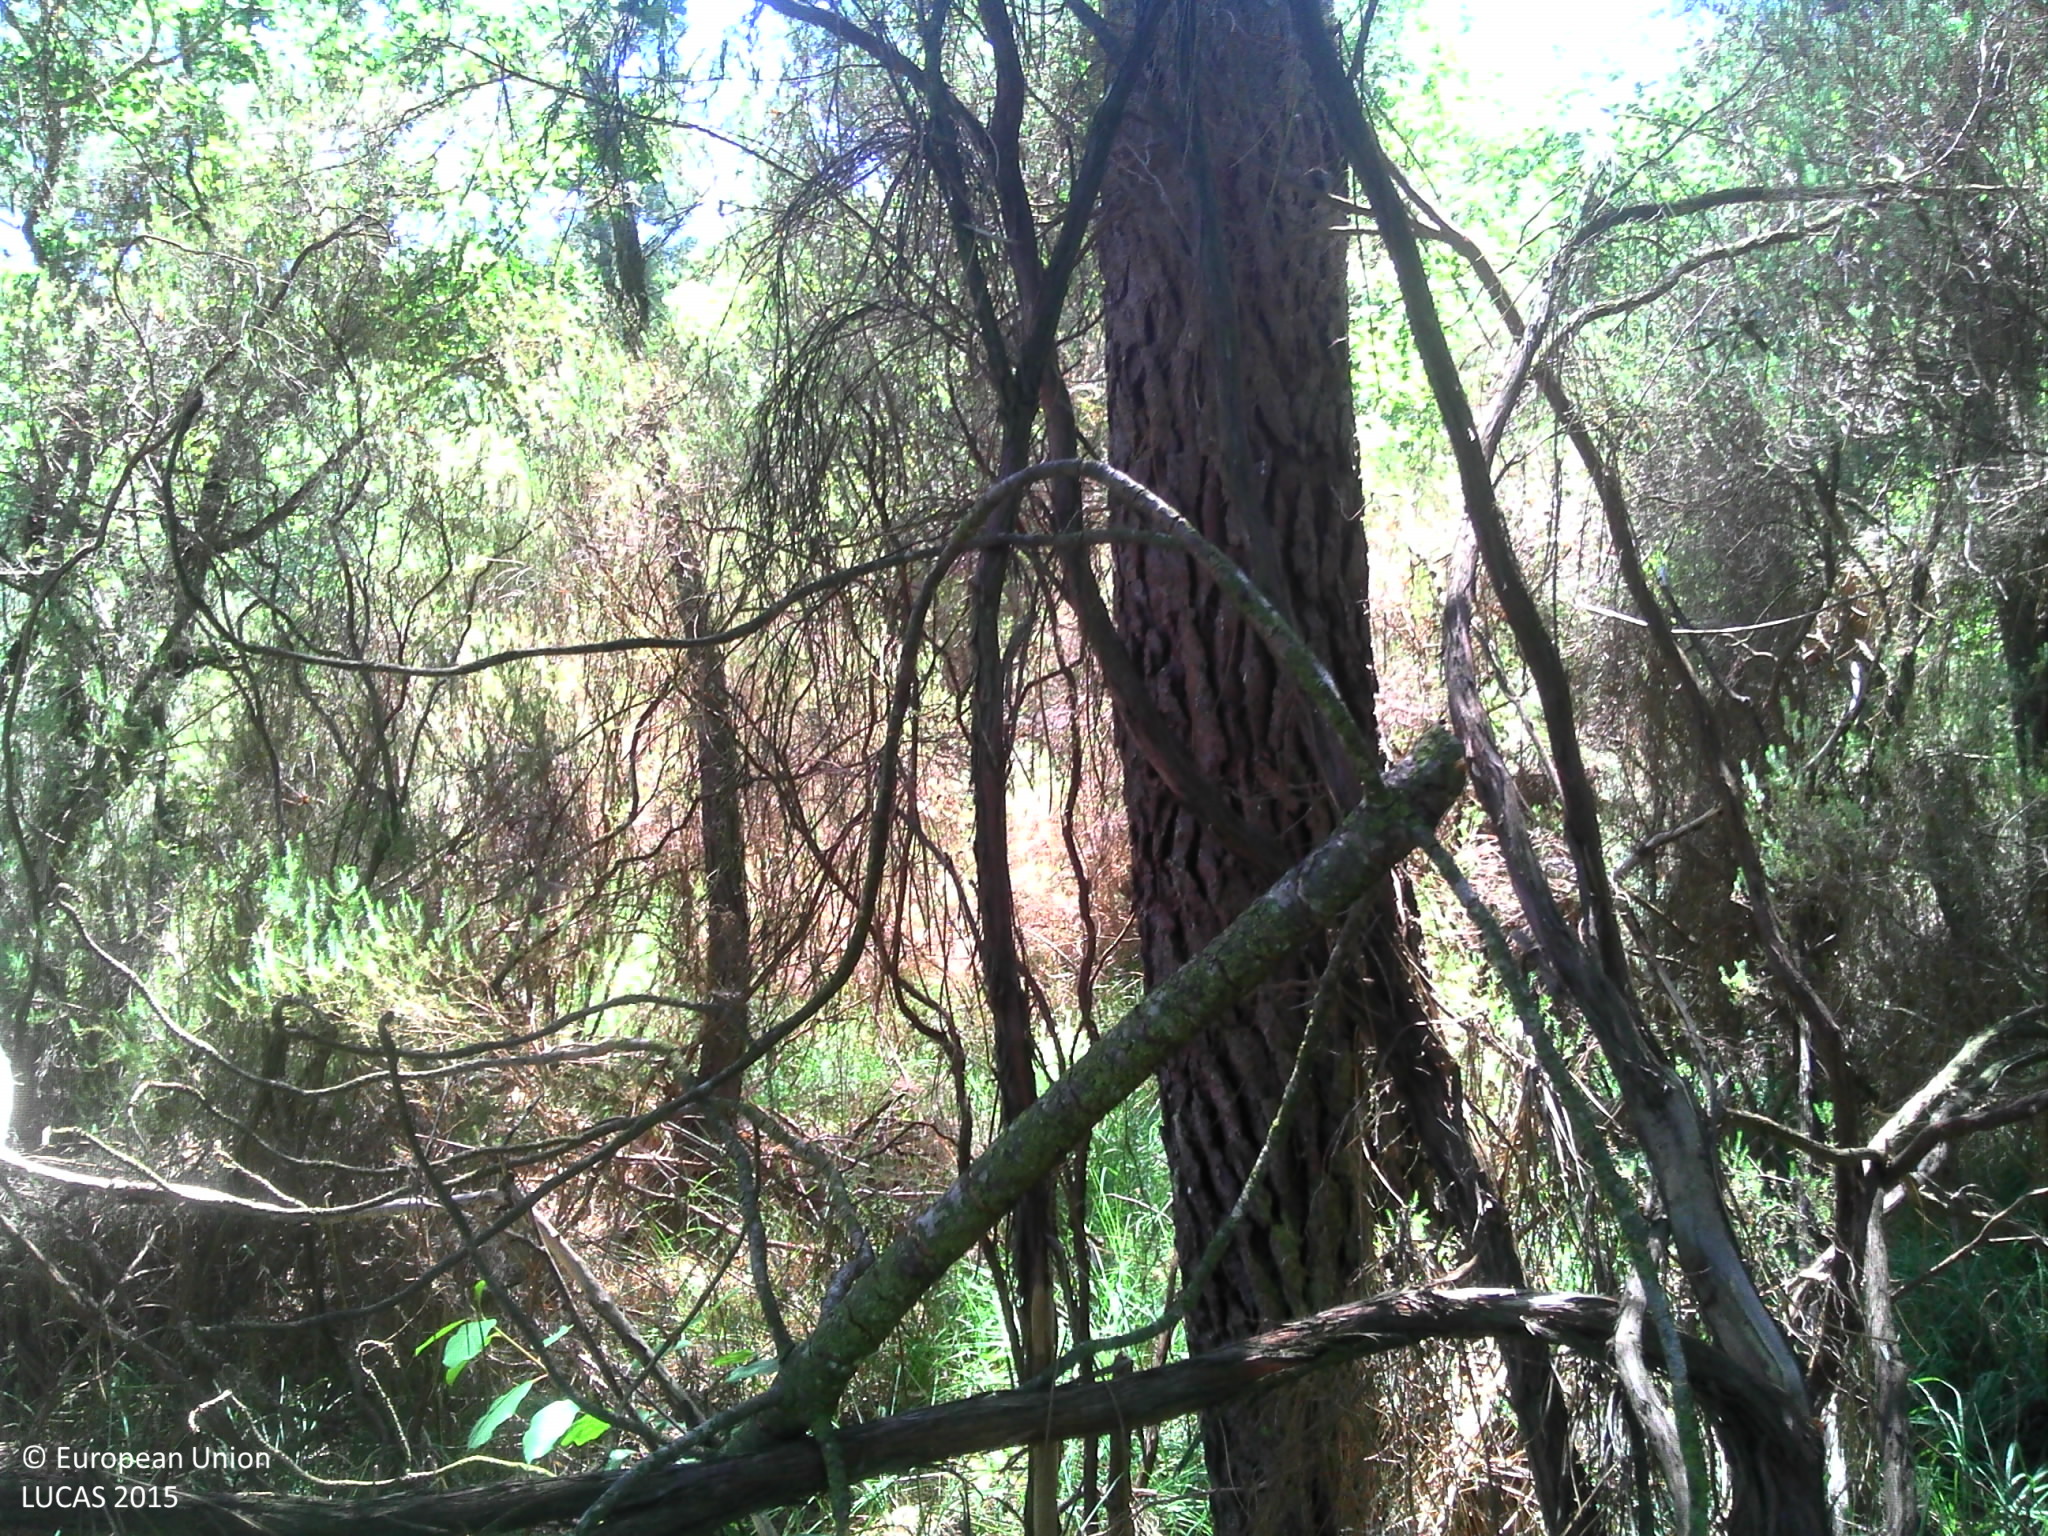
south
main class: Woodland
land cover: Pine dominated mixed woodland
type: mesophytic deciduous forest
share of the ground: > 75 %
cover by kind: broadleaved forest trees 35 %, coniferous forest trees 30 %, shrubs 15 %, herbaceous plants 15 %, lichens and mosses 5 %
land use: Forestry
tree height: > 5 m
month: June
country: FR
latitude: 47.3466
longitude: 0.3547
